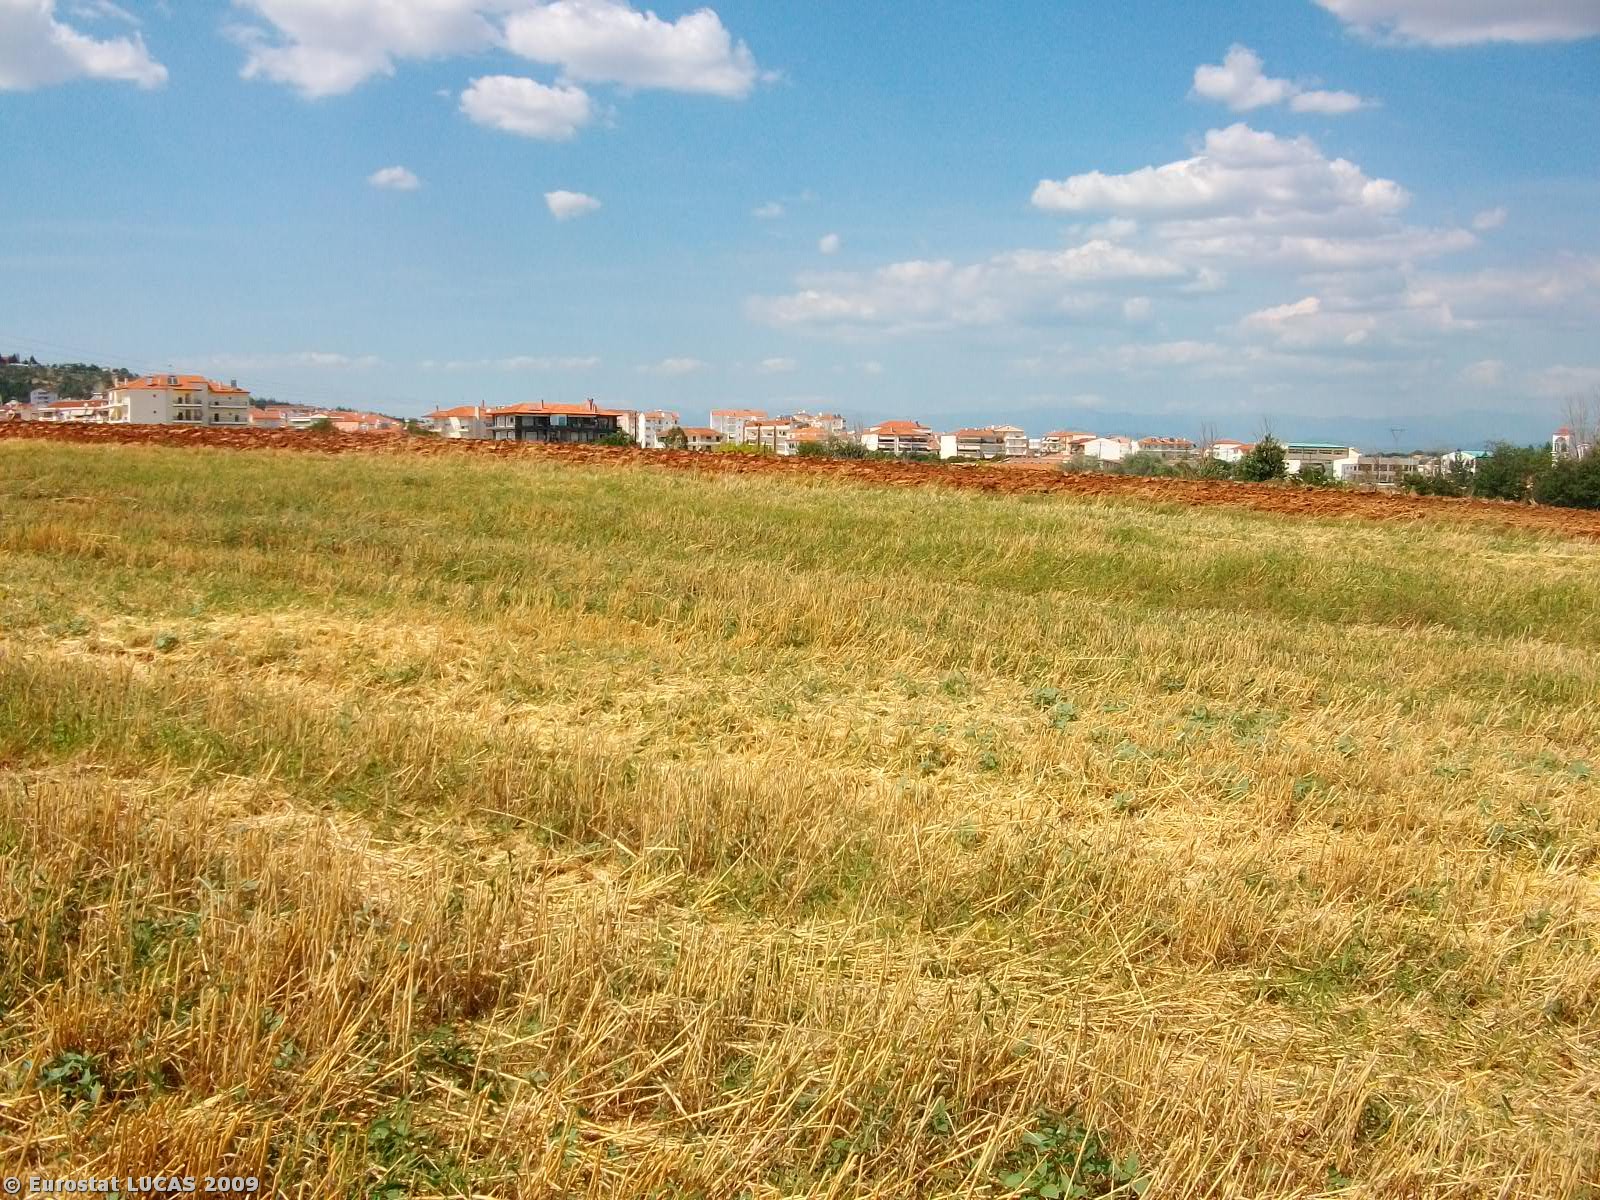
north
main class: Cropland
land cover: Barley
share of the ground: < 10 %
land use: Agriculture (excluding fallow land and kitchen gardens)
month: July
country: GR
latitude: 40.9869
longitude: 22.8832
